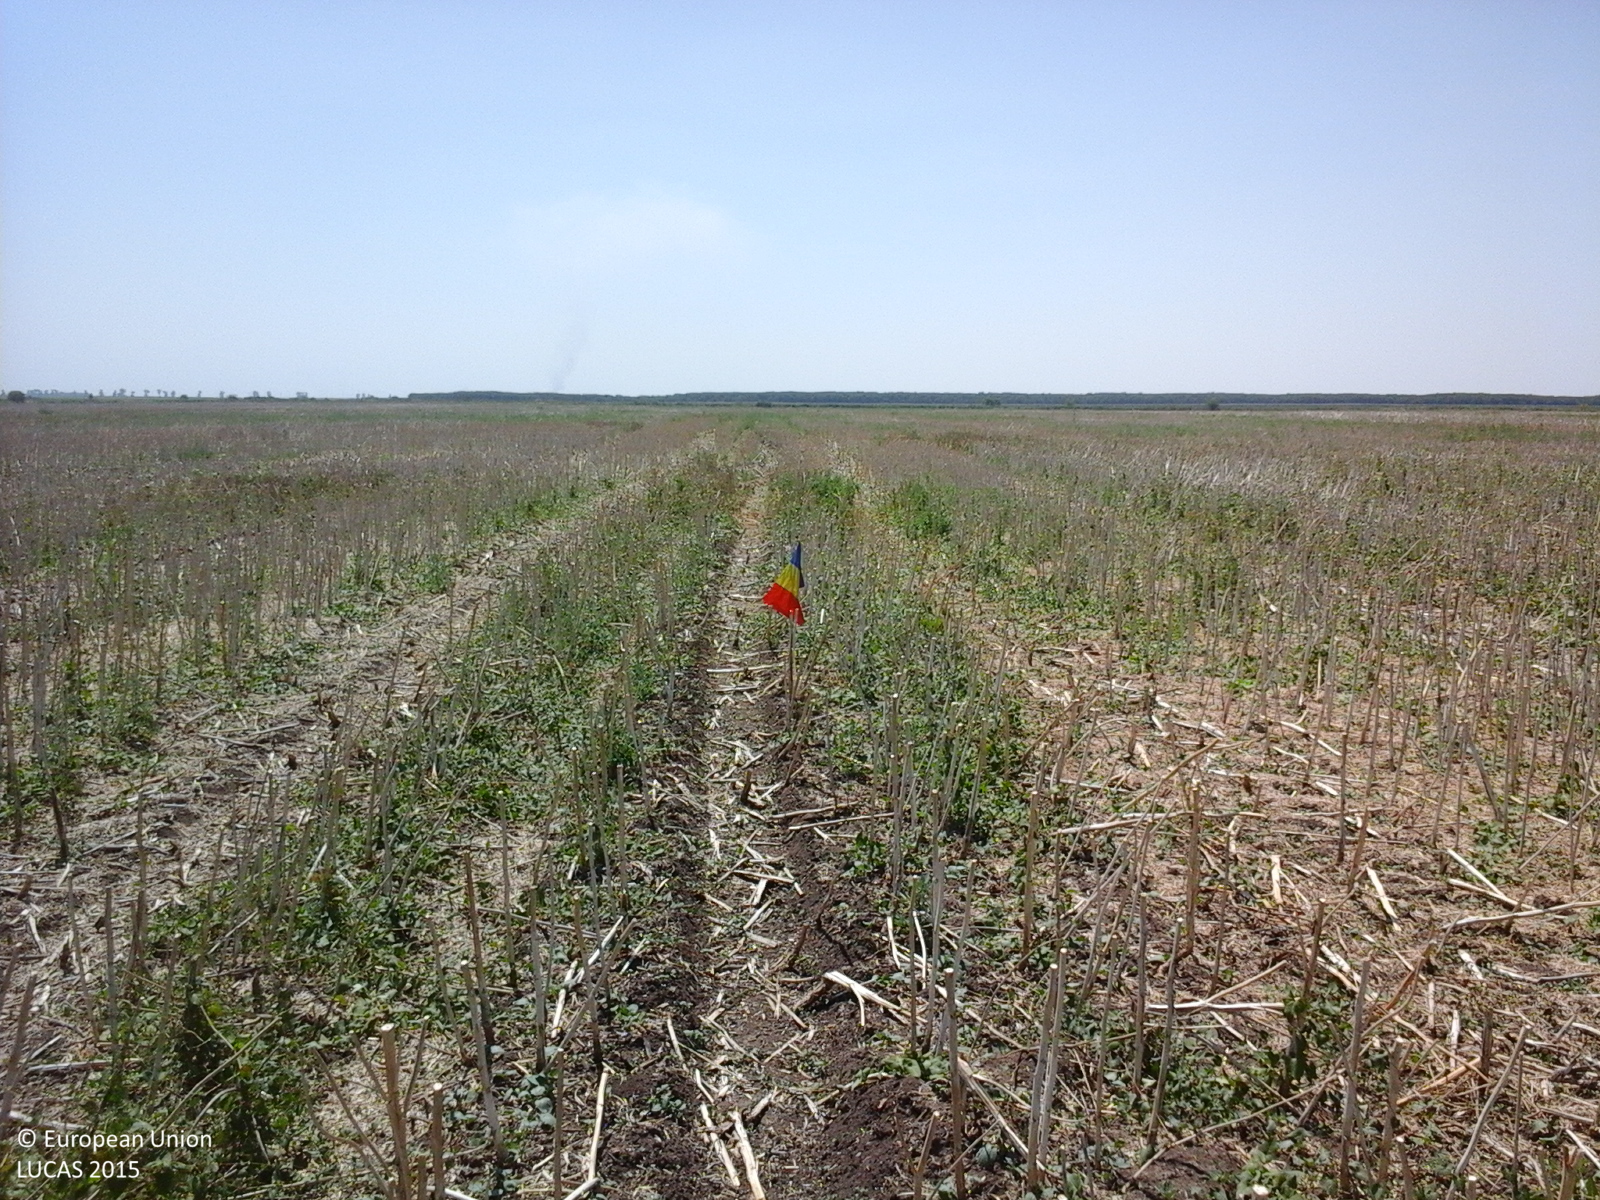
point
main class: Cropland
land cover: Rape and turnip rape
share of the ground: < 10 %
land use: Agriculture (excluding fallow land and kitchen gardens)
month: July
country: RO
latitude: 44.4838
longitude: 27.0929
